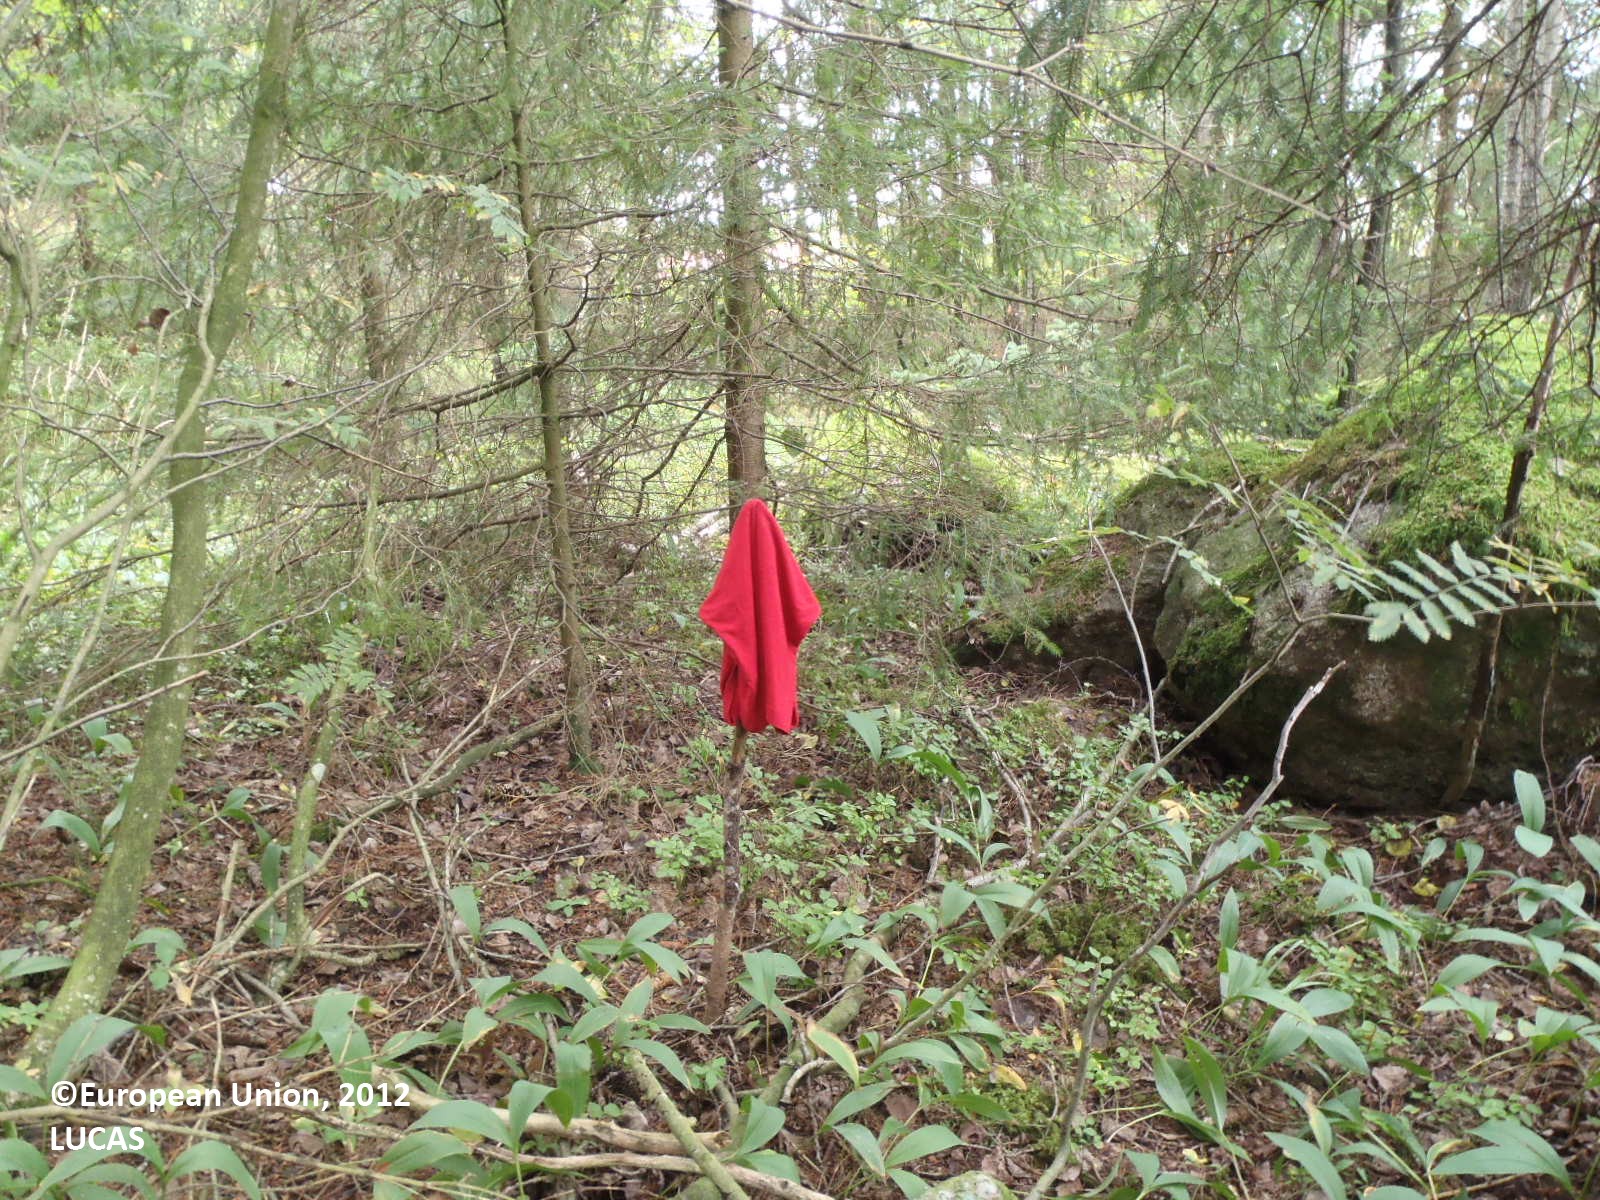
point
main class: Woodland
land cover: Spruce dominated coniferous woodland
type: boreal forest
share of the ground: > 75 %
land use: Forestry
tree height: > 5 m
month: August
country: FI
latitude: 60.7161
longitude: 21.8815
